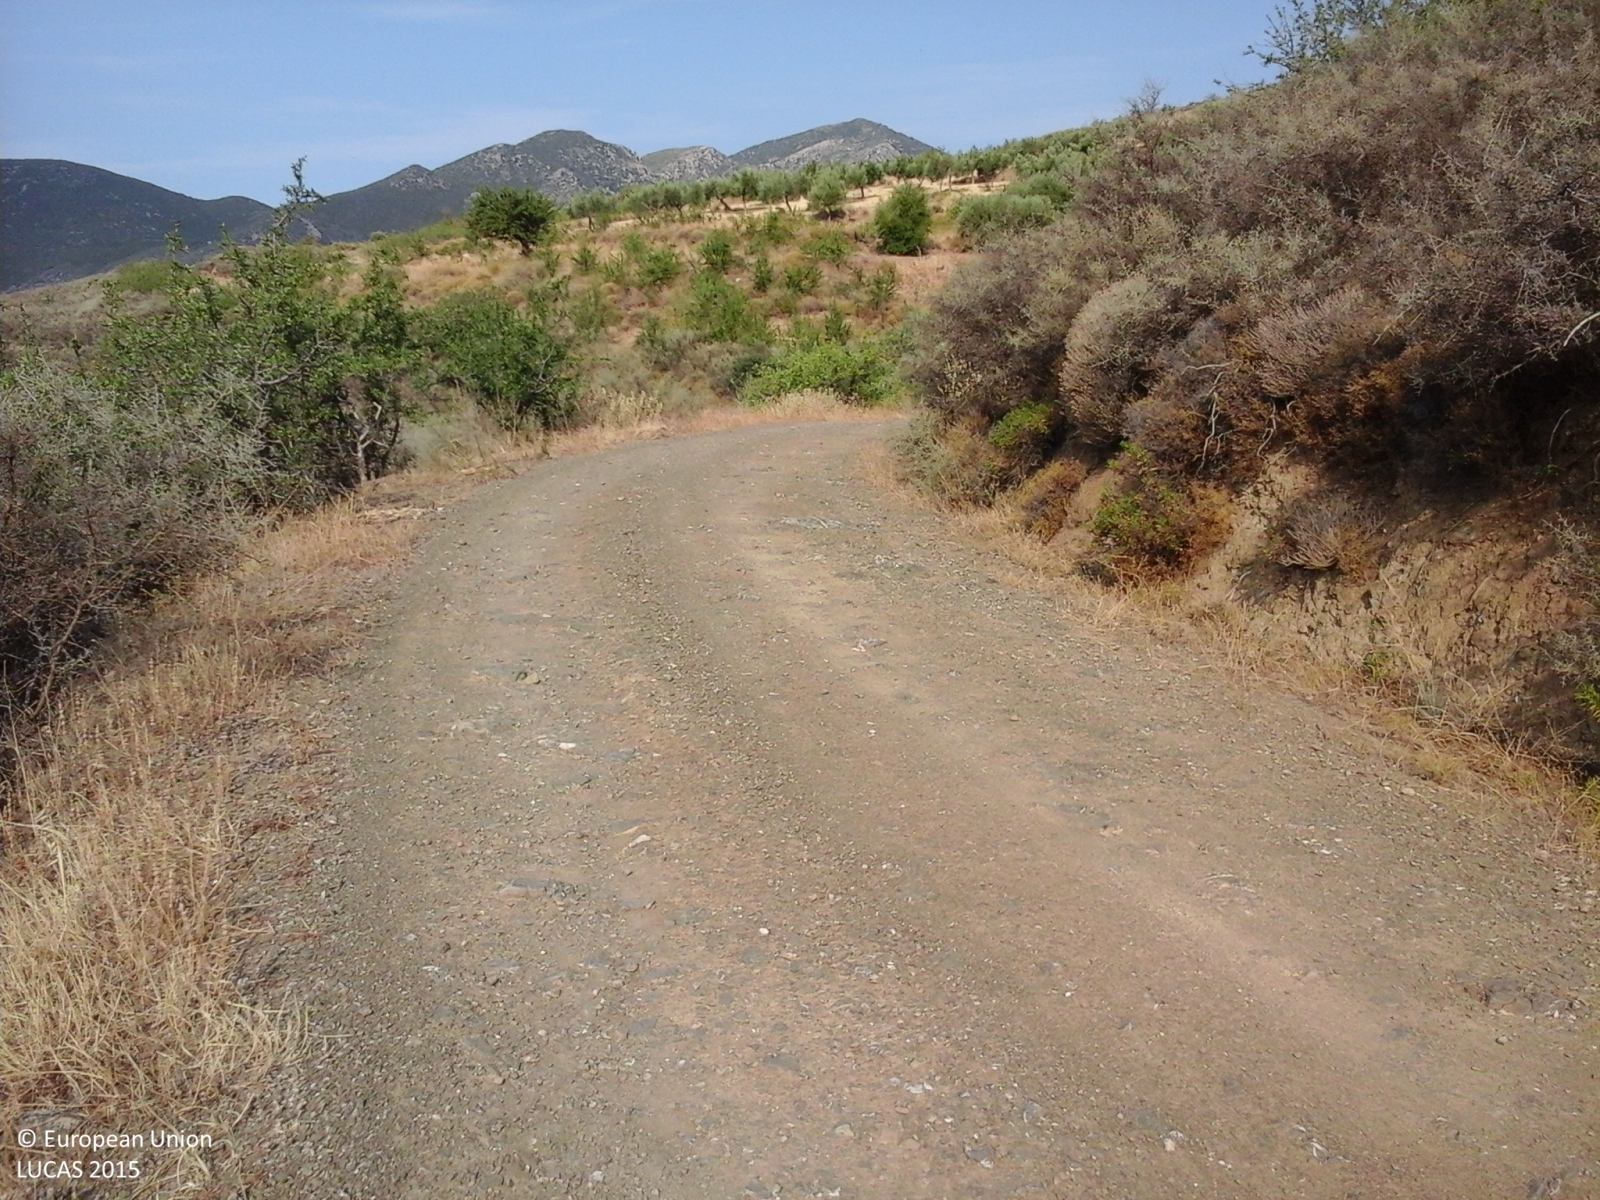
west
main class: Shrubland
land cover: Shrubland without tree cover
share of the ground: > 75 %
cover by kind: shrubs 90 %, herbaceous plants 10 %
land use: Semi-natural and natural areas not in use
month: August
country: GR
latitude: 38.3858
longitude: 22.2106
